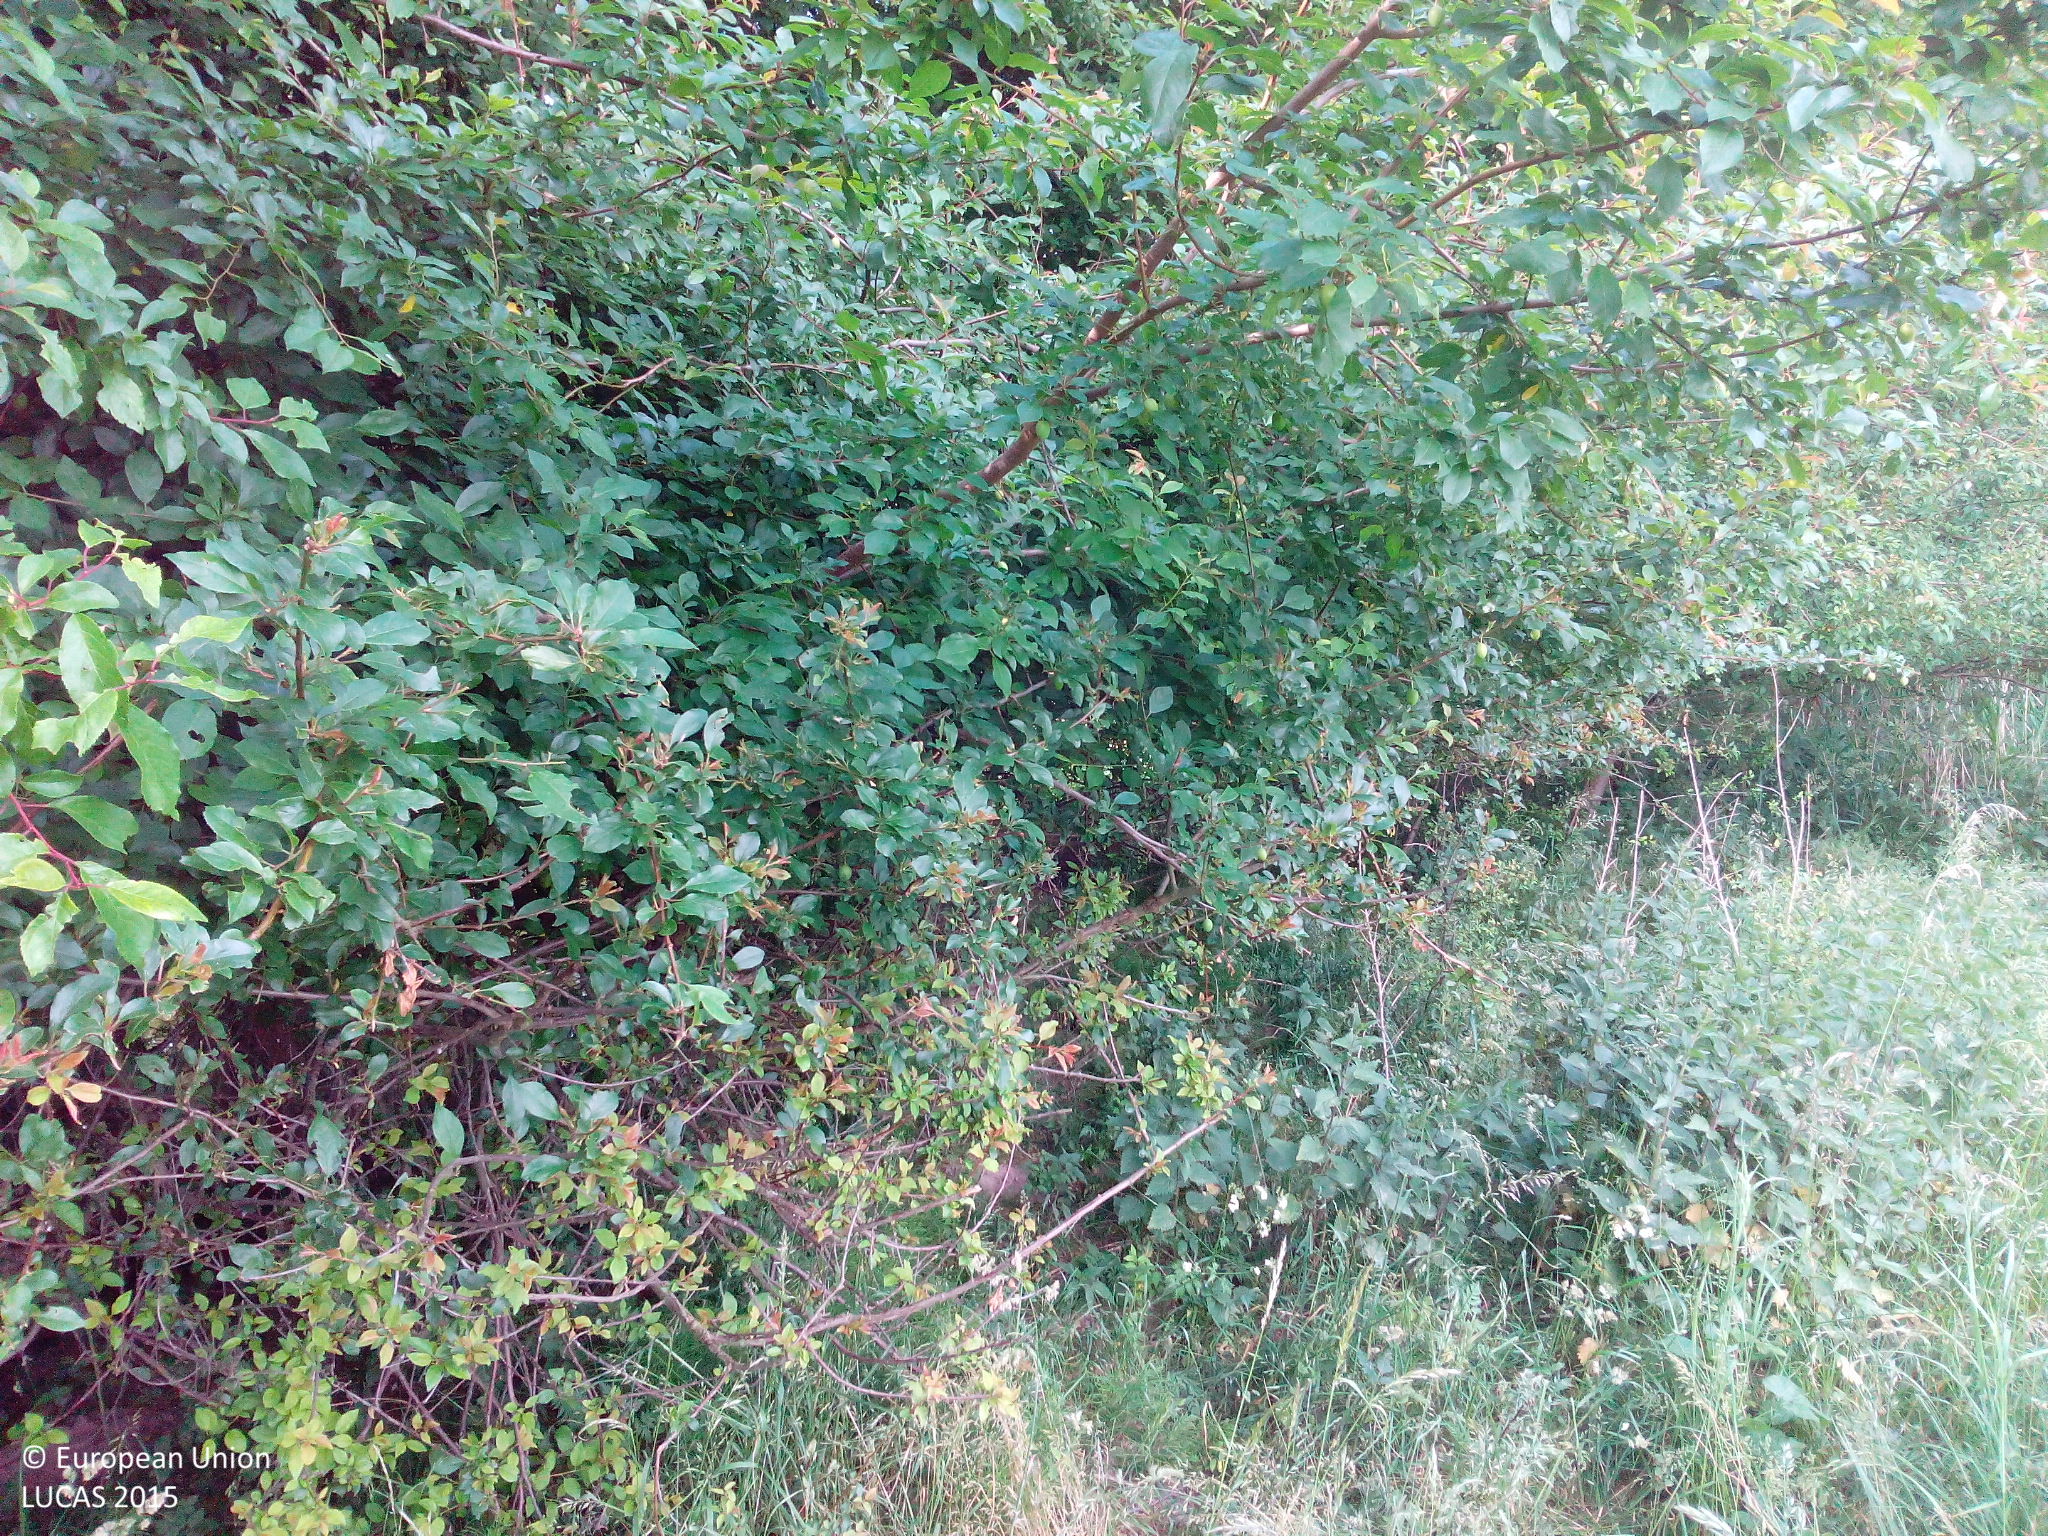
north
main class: Woodland
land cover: Broadleaved woodland
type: mesophytic deciduous forest
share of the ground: > 75 %
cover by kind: broadleaved forest trees 90 %, herbaceous plants 10 %
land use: Forestry
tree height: > 5 m
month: June
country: DE
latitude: 53.2657
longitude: 12.6232
